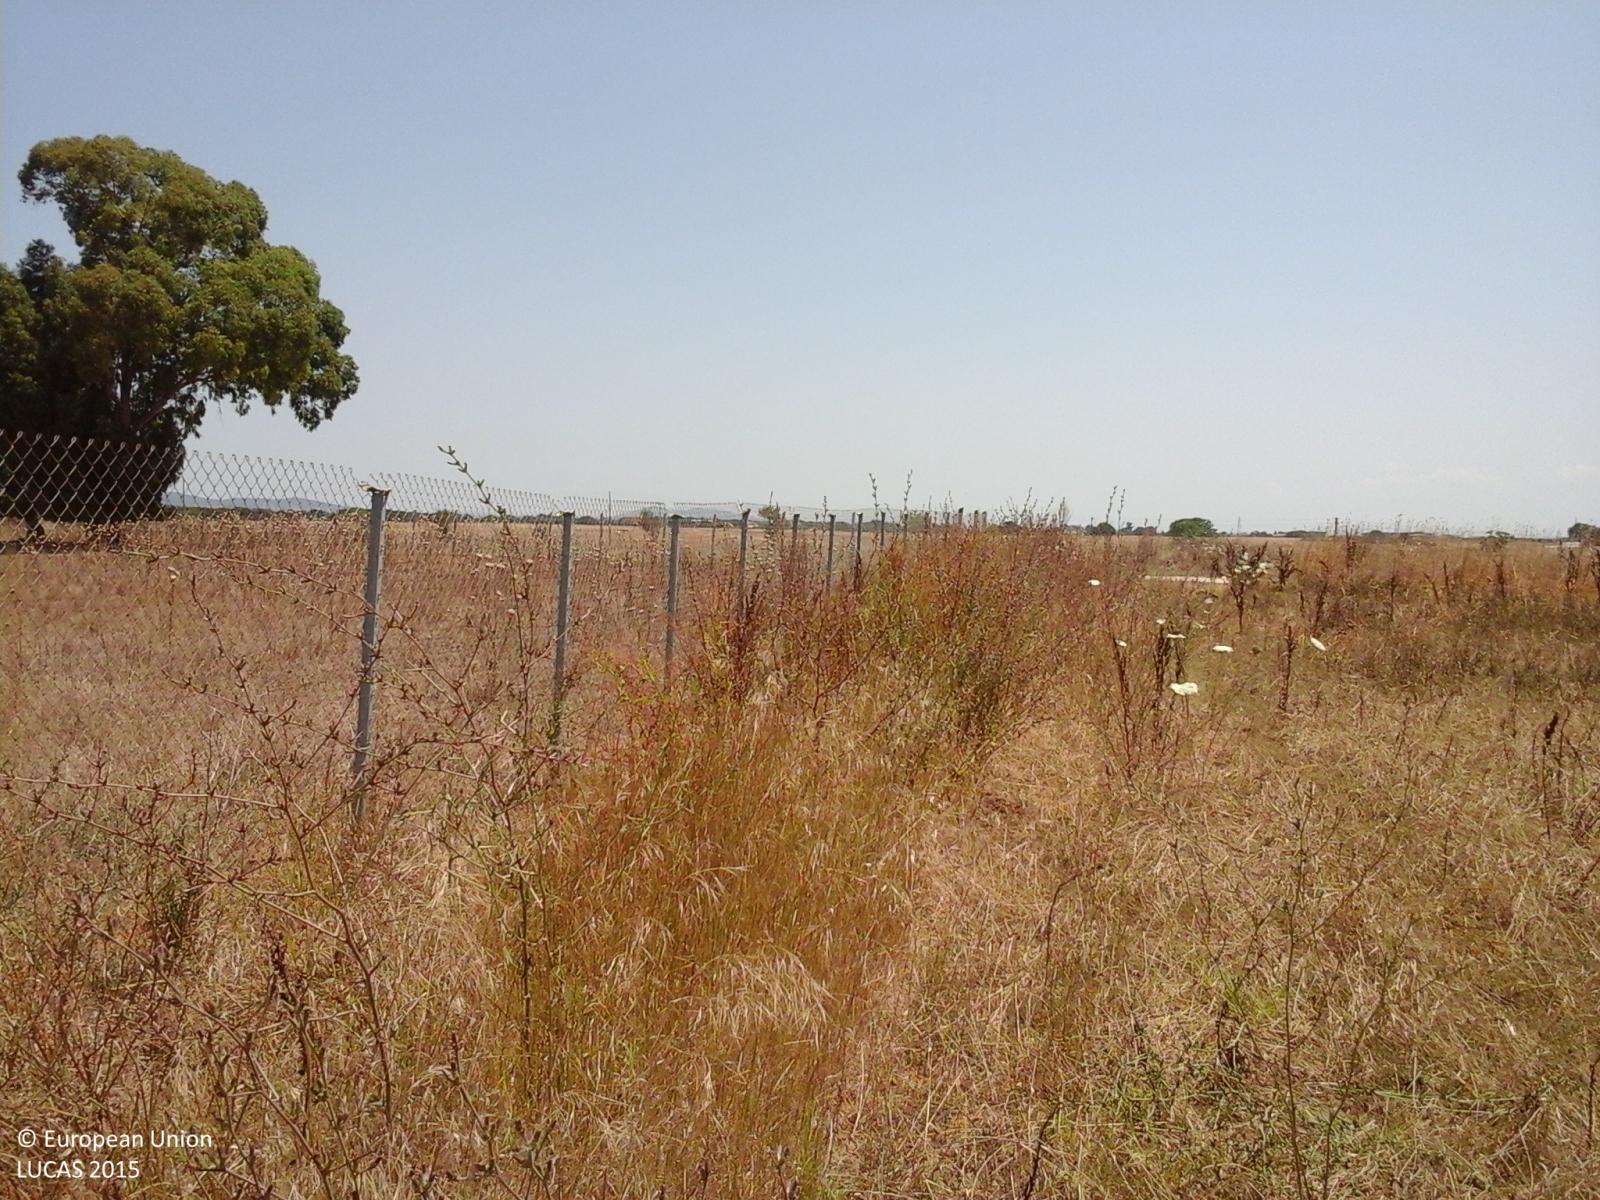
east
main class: Grassland
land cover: Grassland without tree/shrub cover
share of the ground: > 75 %
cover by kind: herbaceous plants 100 %
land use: Agriculture (excluding fallow land and kitchen gardens)
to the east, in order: Grassland without tree/shrub cover; Fences; Grass margins; Ditches and canals; Paved roads, cycling and walking lanes; Ditches and canals; Grass margins; Barley
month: July
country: IT
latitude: 42.4089
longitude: 11.4409
